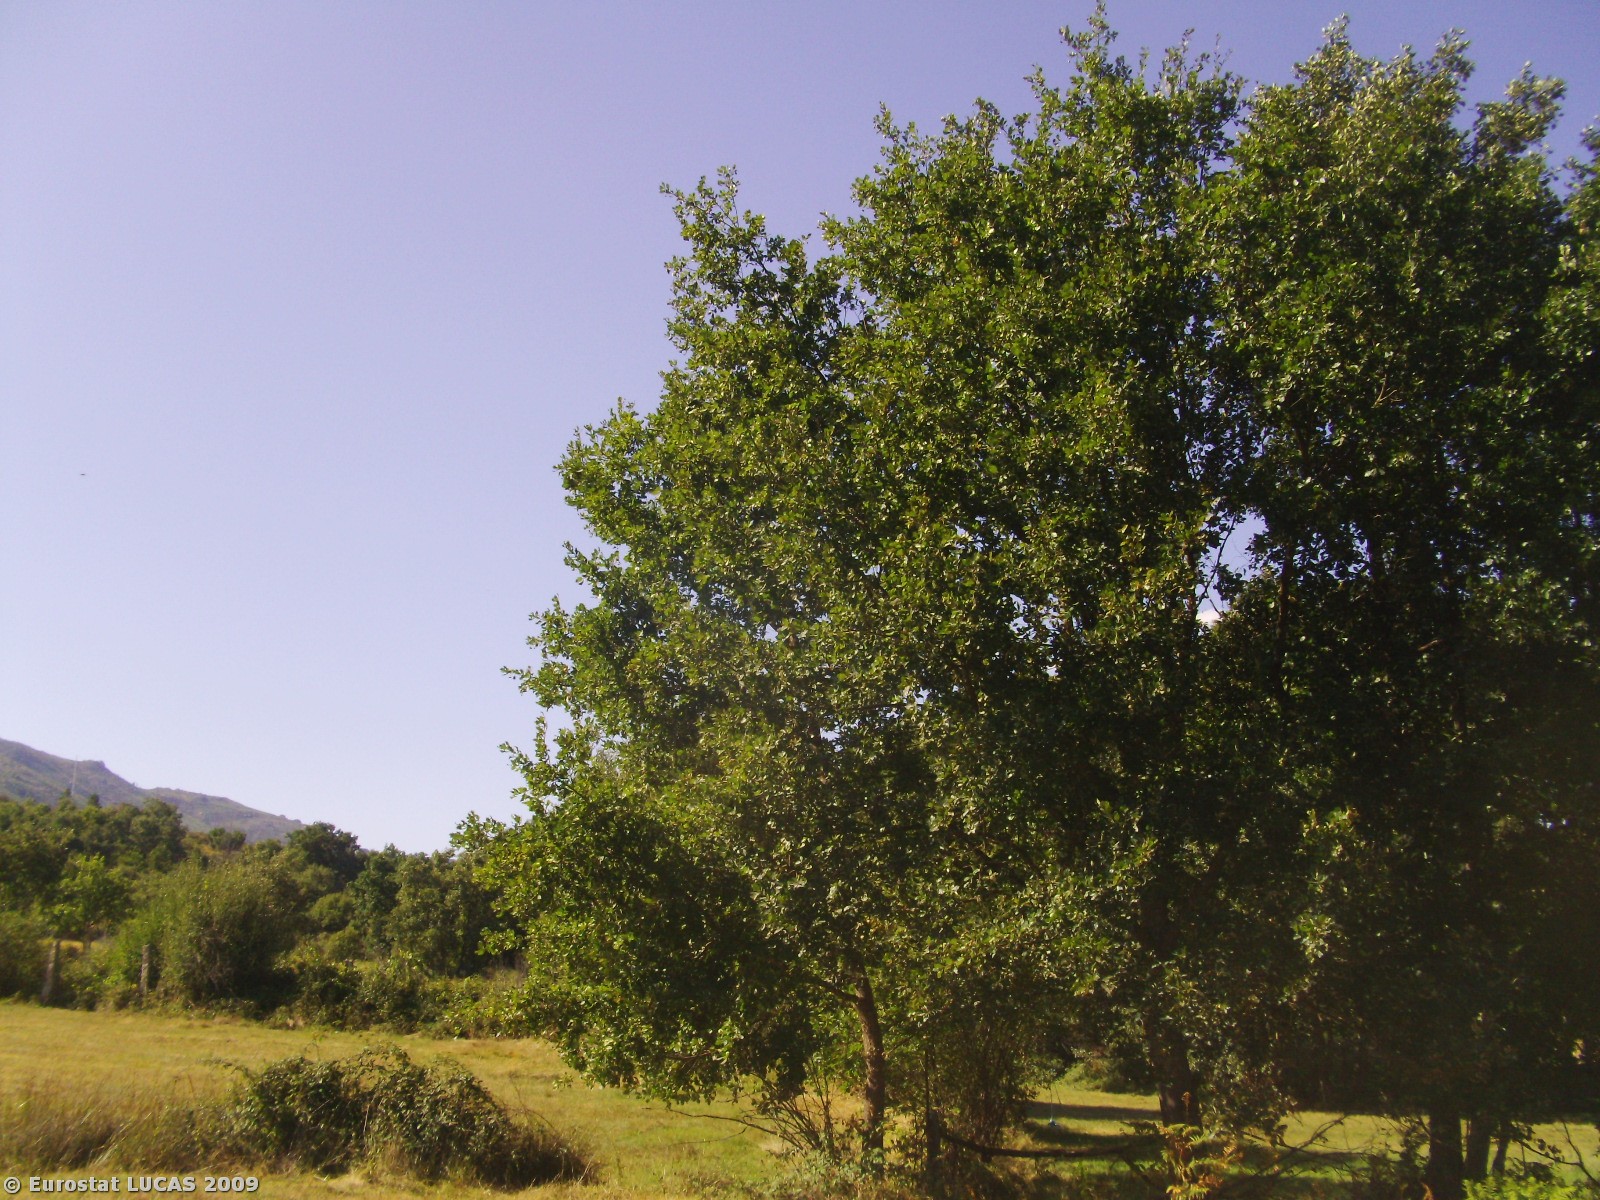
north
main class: Grassland
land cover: Spontaneously vegetated surfaces
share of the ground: > 75 %
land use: Fallow land
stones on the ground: < 10 %
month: August
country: PT
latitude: 41.7430
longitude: -7.6054
